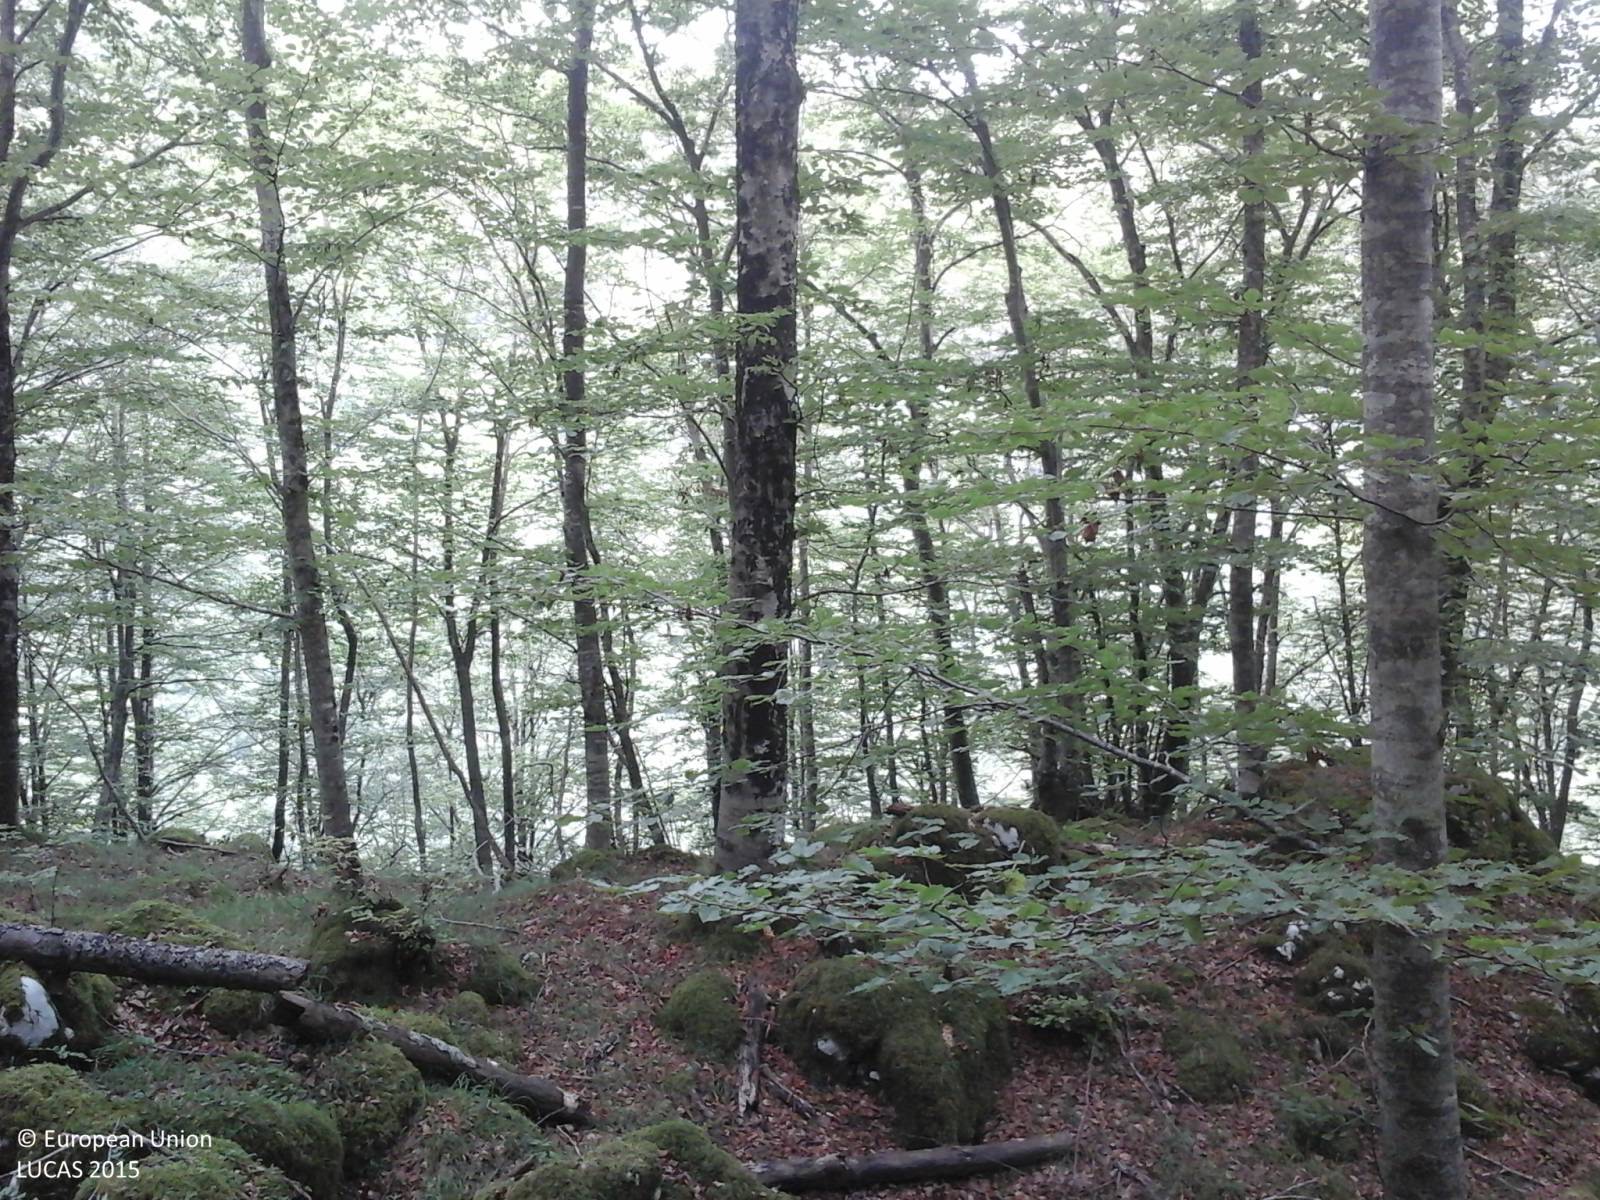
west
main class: Woodland
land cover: Broadleaved woodland
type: mountainous beech forest
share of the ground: > 75 %
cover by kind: broadleaved forest trees 100 %
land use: Forestry
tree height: > 5 m
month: July
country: IT
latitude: 46.1767
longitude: 12.5488
